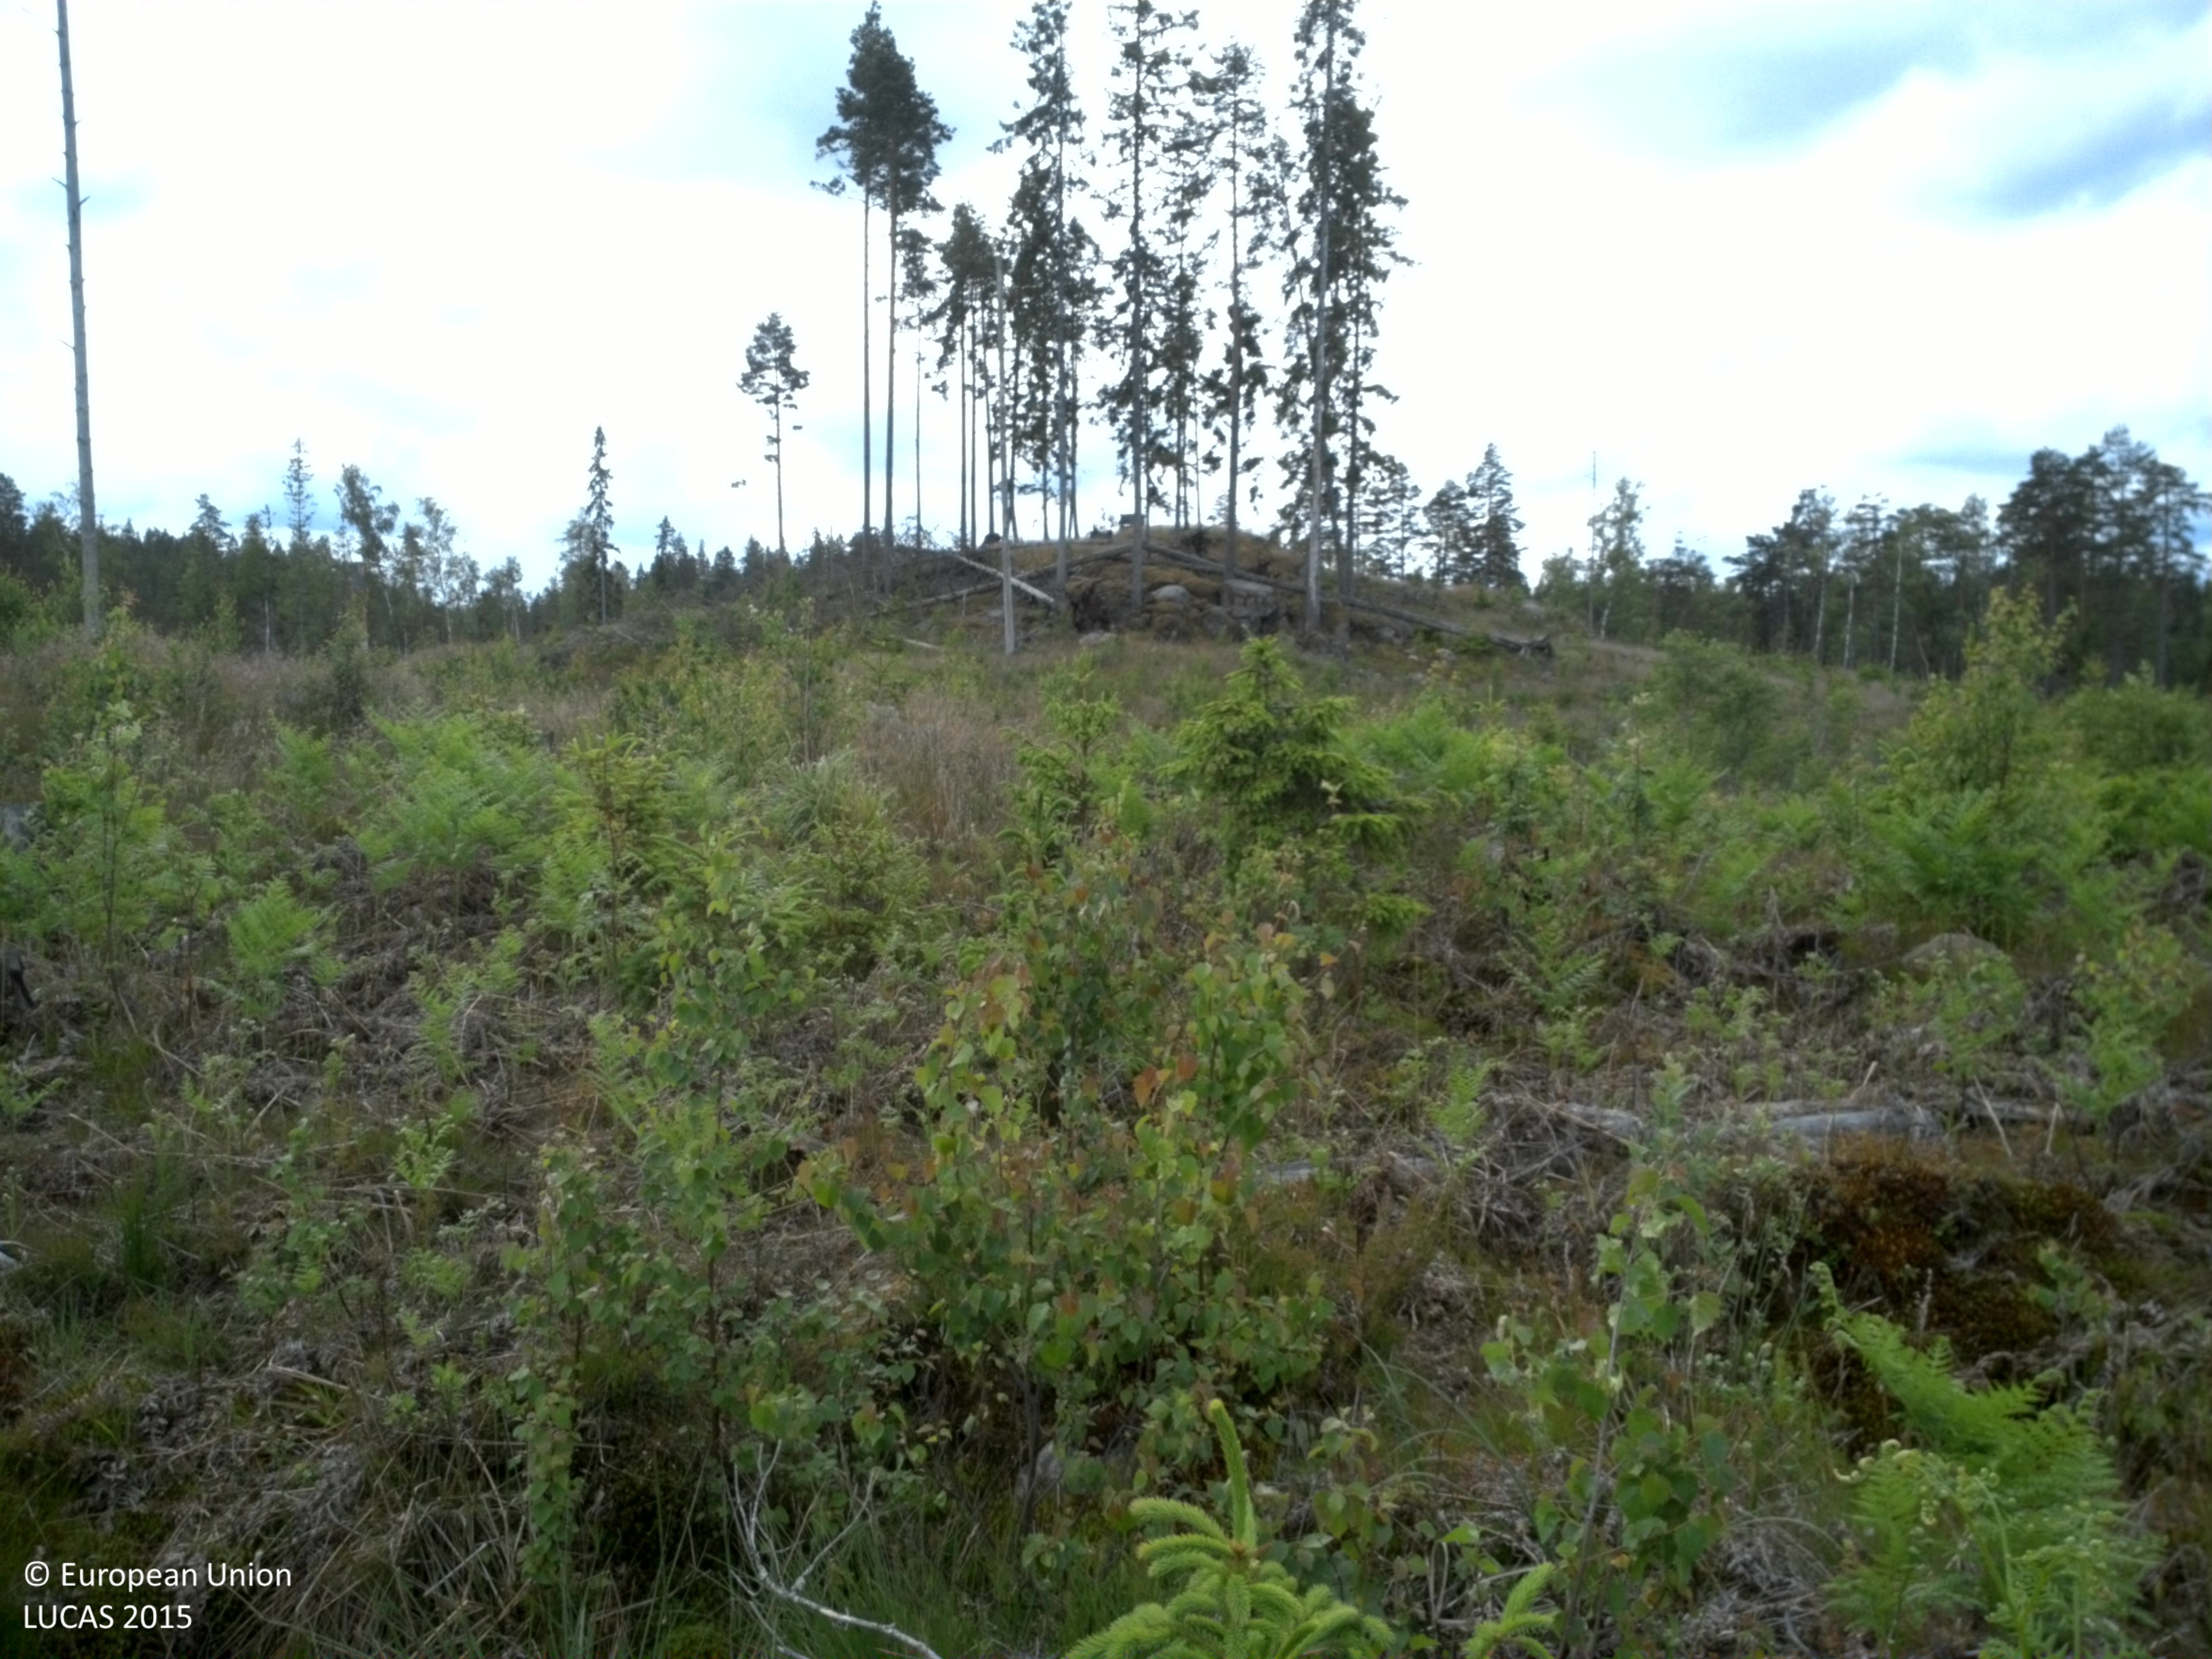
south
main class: Woodland
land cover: Spruce dominated mixed woodland
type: boreal forest
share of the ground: 50 - 75 %
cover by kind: coniferous forest trees 35 %, herbaceous plants 30 %, broadleaved forest trees 25 %, lichens and mosses 10 %
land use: Forestry
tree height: < 5 m
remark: Clear cut
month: June
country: SE
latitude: 58.6484
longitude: 15.4907
